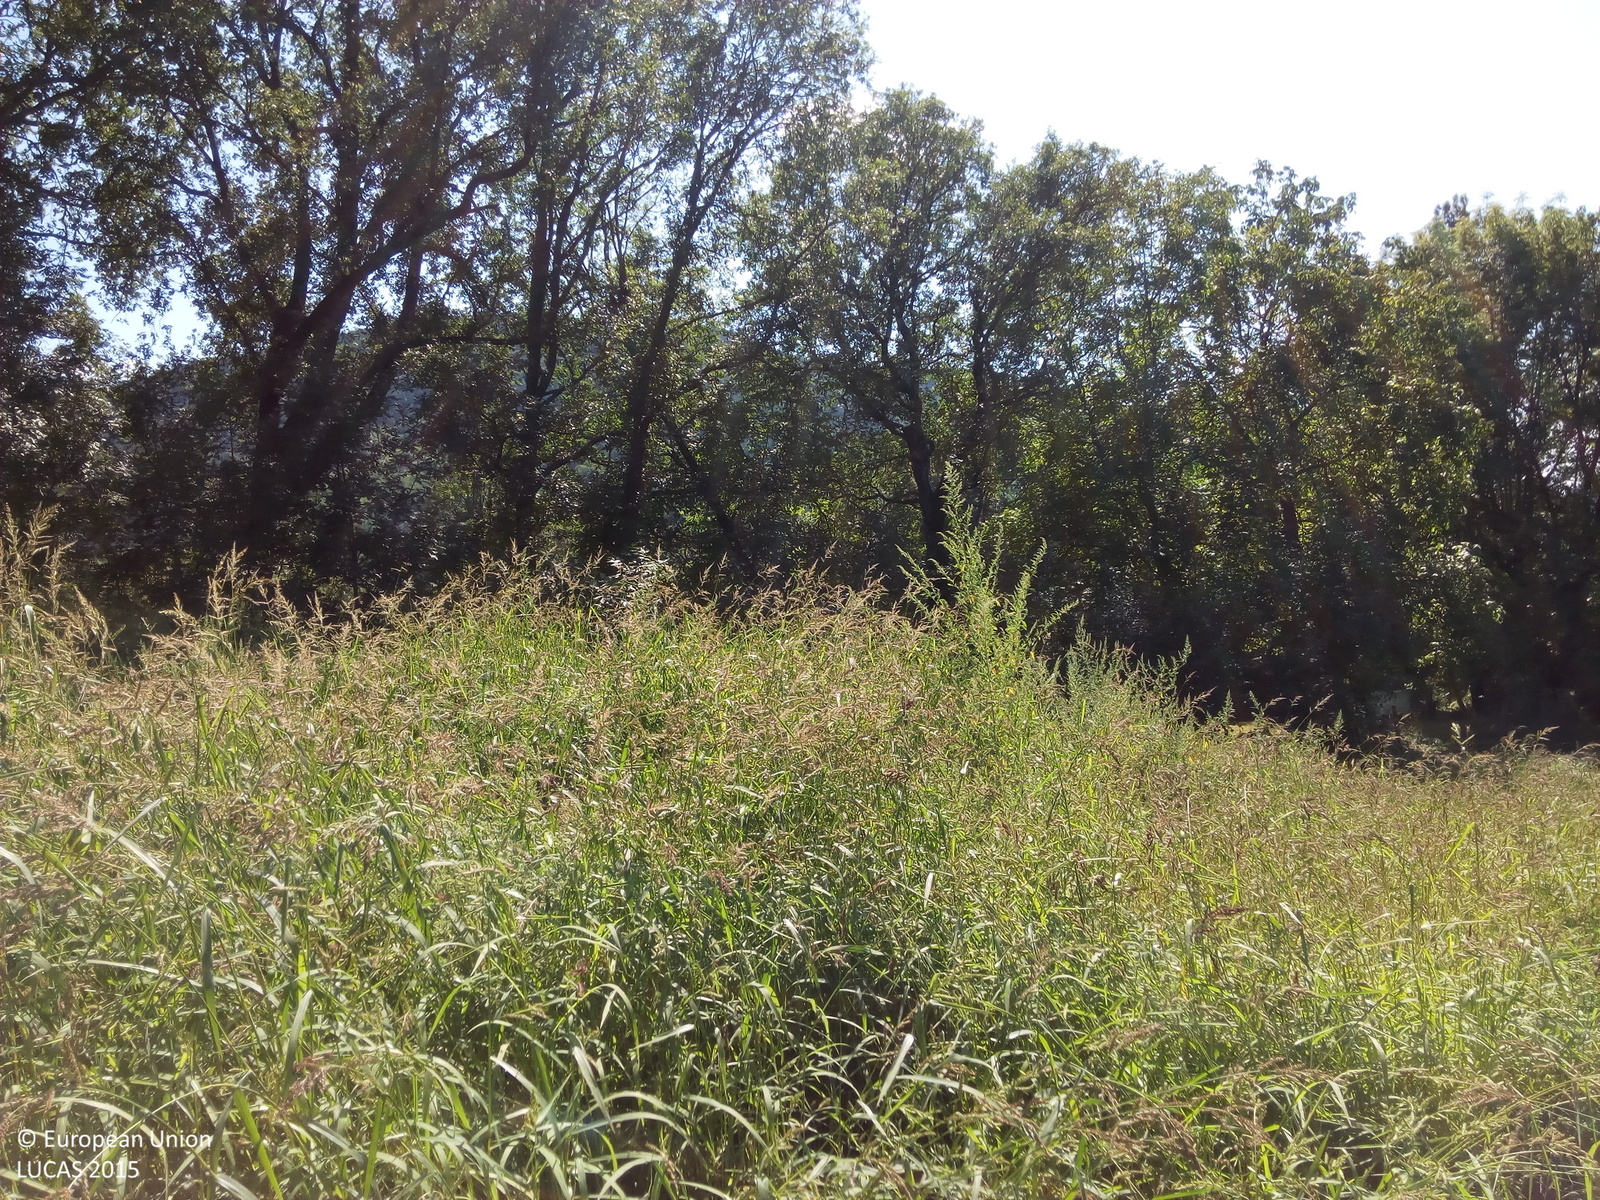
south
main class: Cropland
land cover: Other cereals
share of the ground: > 75 %
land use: Agriculture (excluding fallow land and kitchen gardens)
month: September
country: ES
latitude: 42.5154
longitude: 0.4986
